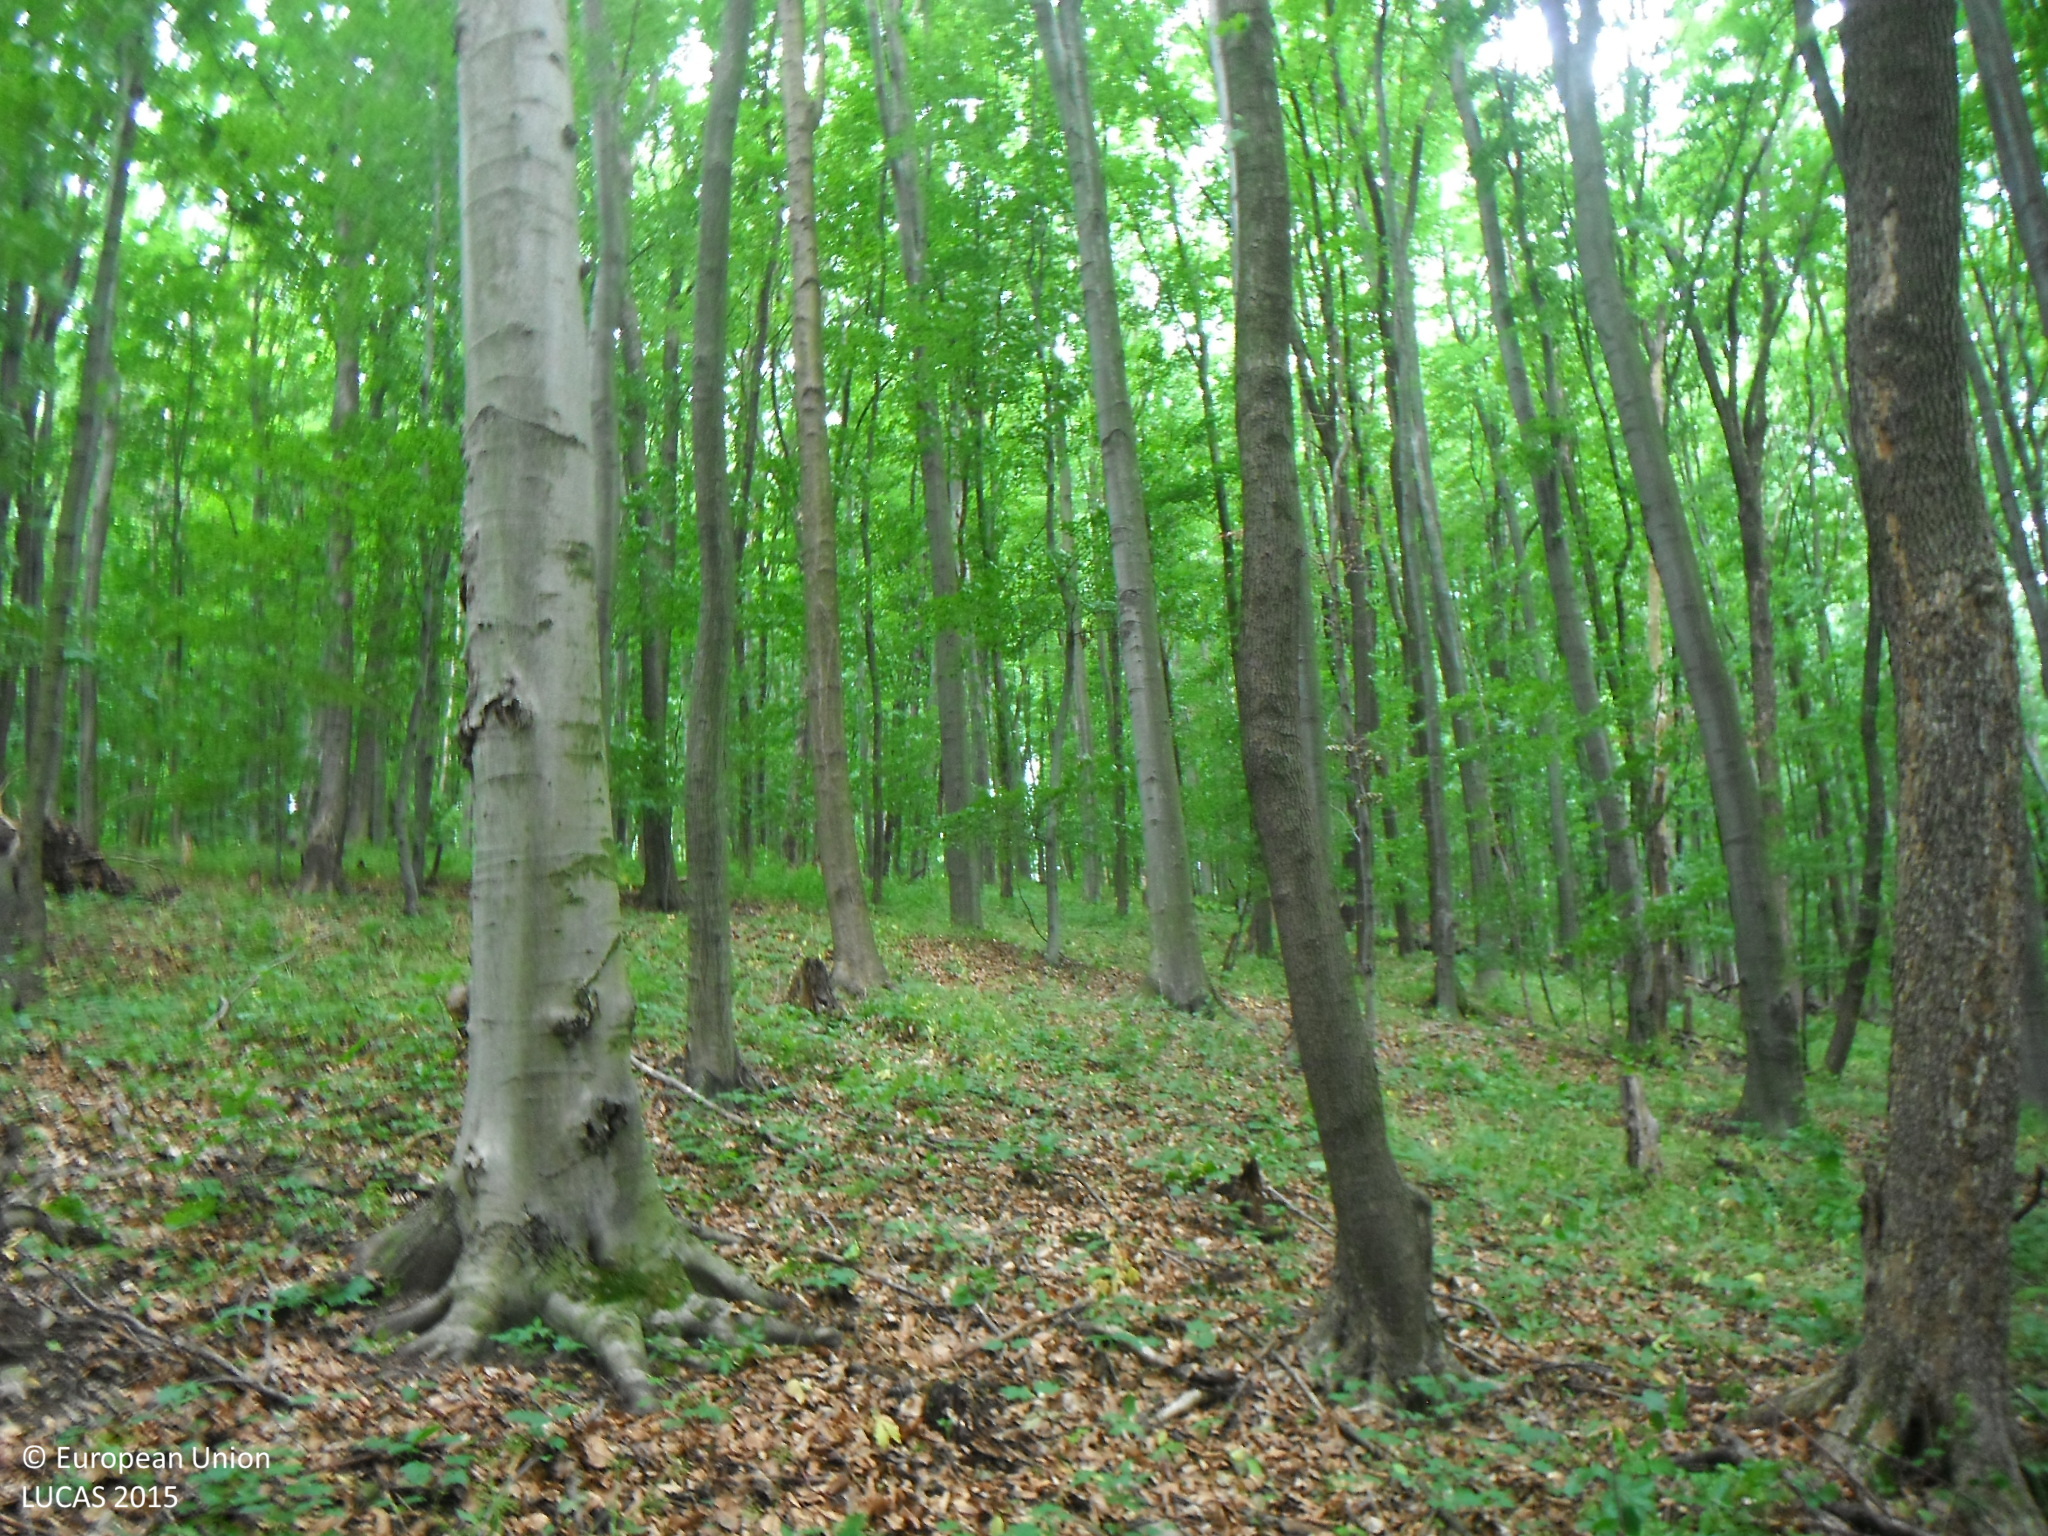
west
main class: Woodland
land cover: Broadleaved woodland
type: beech forest
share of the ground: > 75 %
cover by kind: broadleaved forest trees 100 %
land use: Forestry
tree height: > 5 m
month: June
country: SK
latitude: 49.1677
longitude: 21.6400
